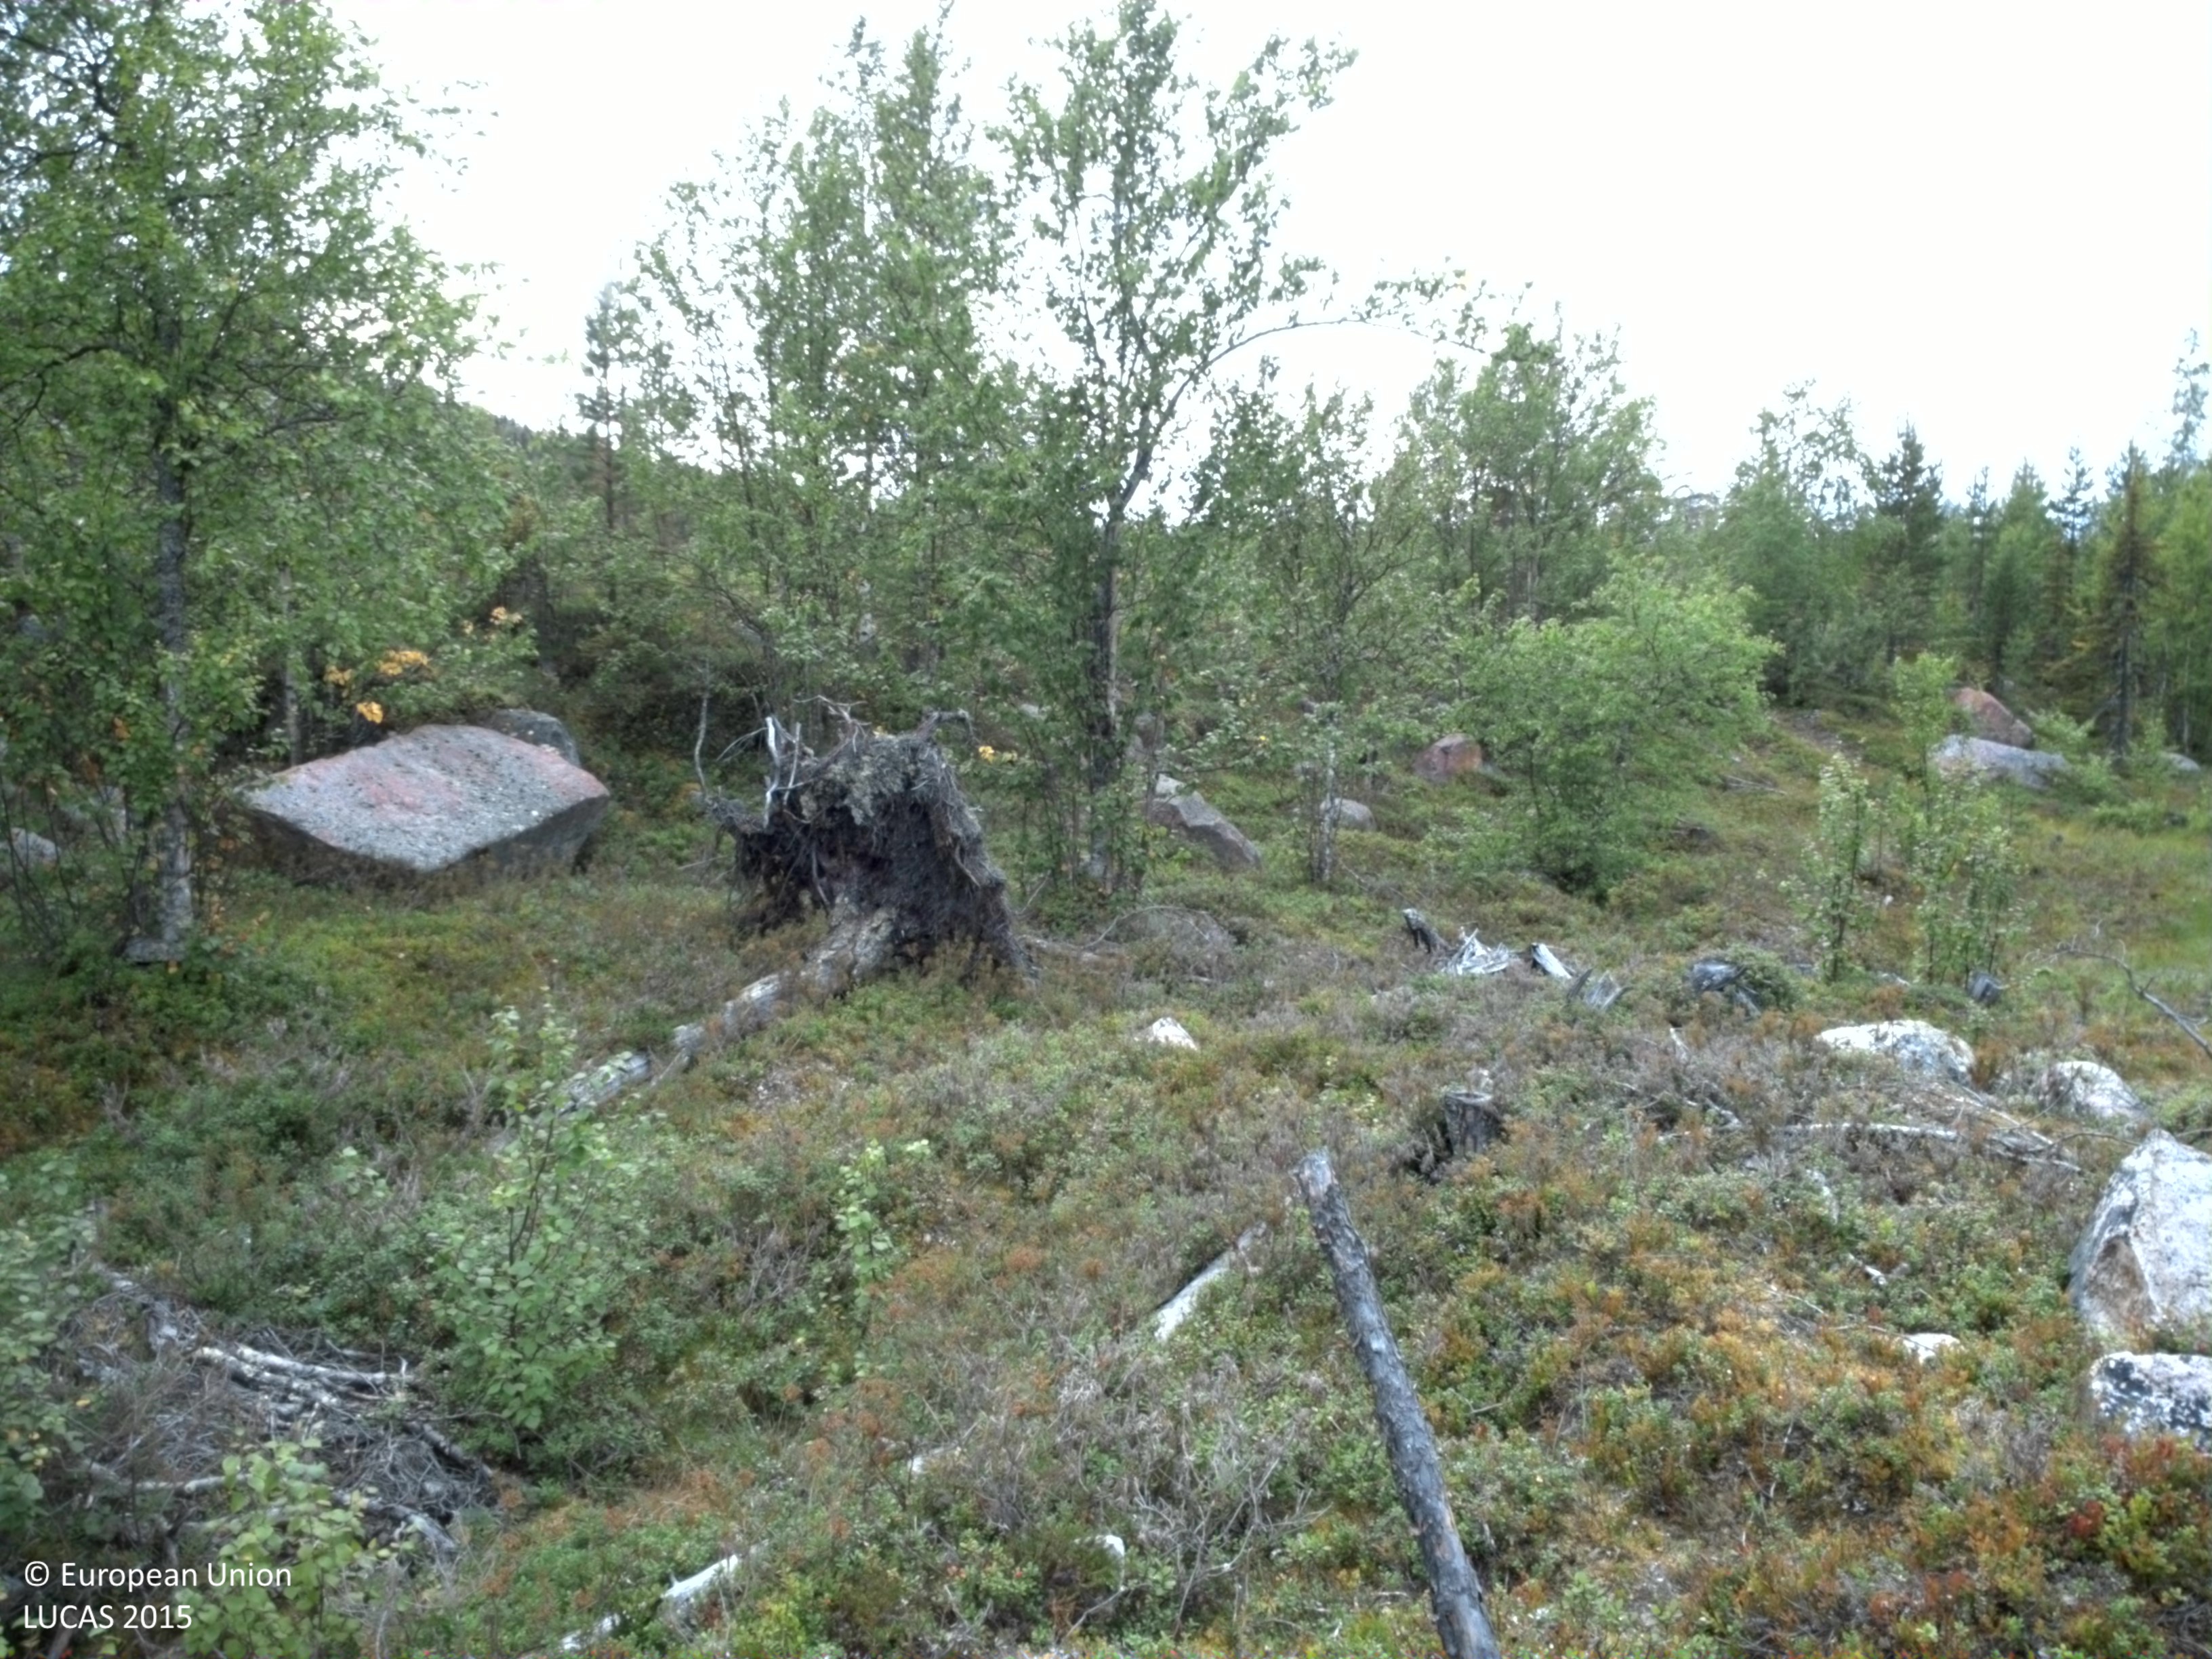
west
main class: Shrubland
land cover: Shrubland with sparse tree cover
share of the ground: > 75 %
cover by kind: shrubs 75 %, lichens and mosses 15 %, broadleaved forest trees 5 %, consolidated bare surface 5 %
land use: Forestry
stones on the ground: 25 - 50 %
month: August
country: SE
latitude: 66.5442
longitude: 19.3851
